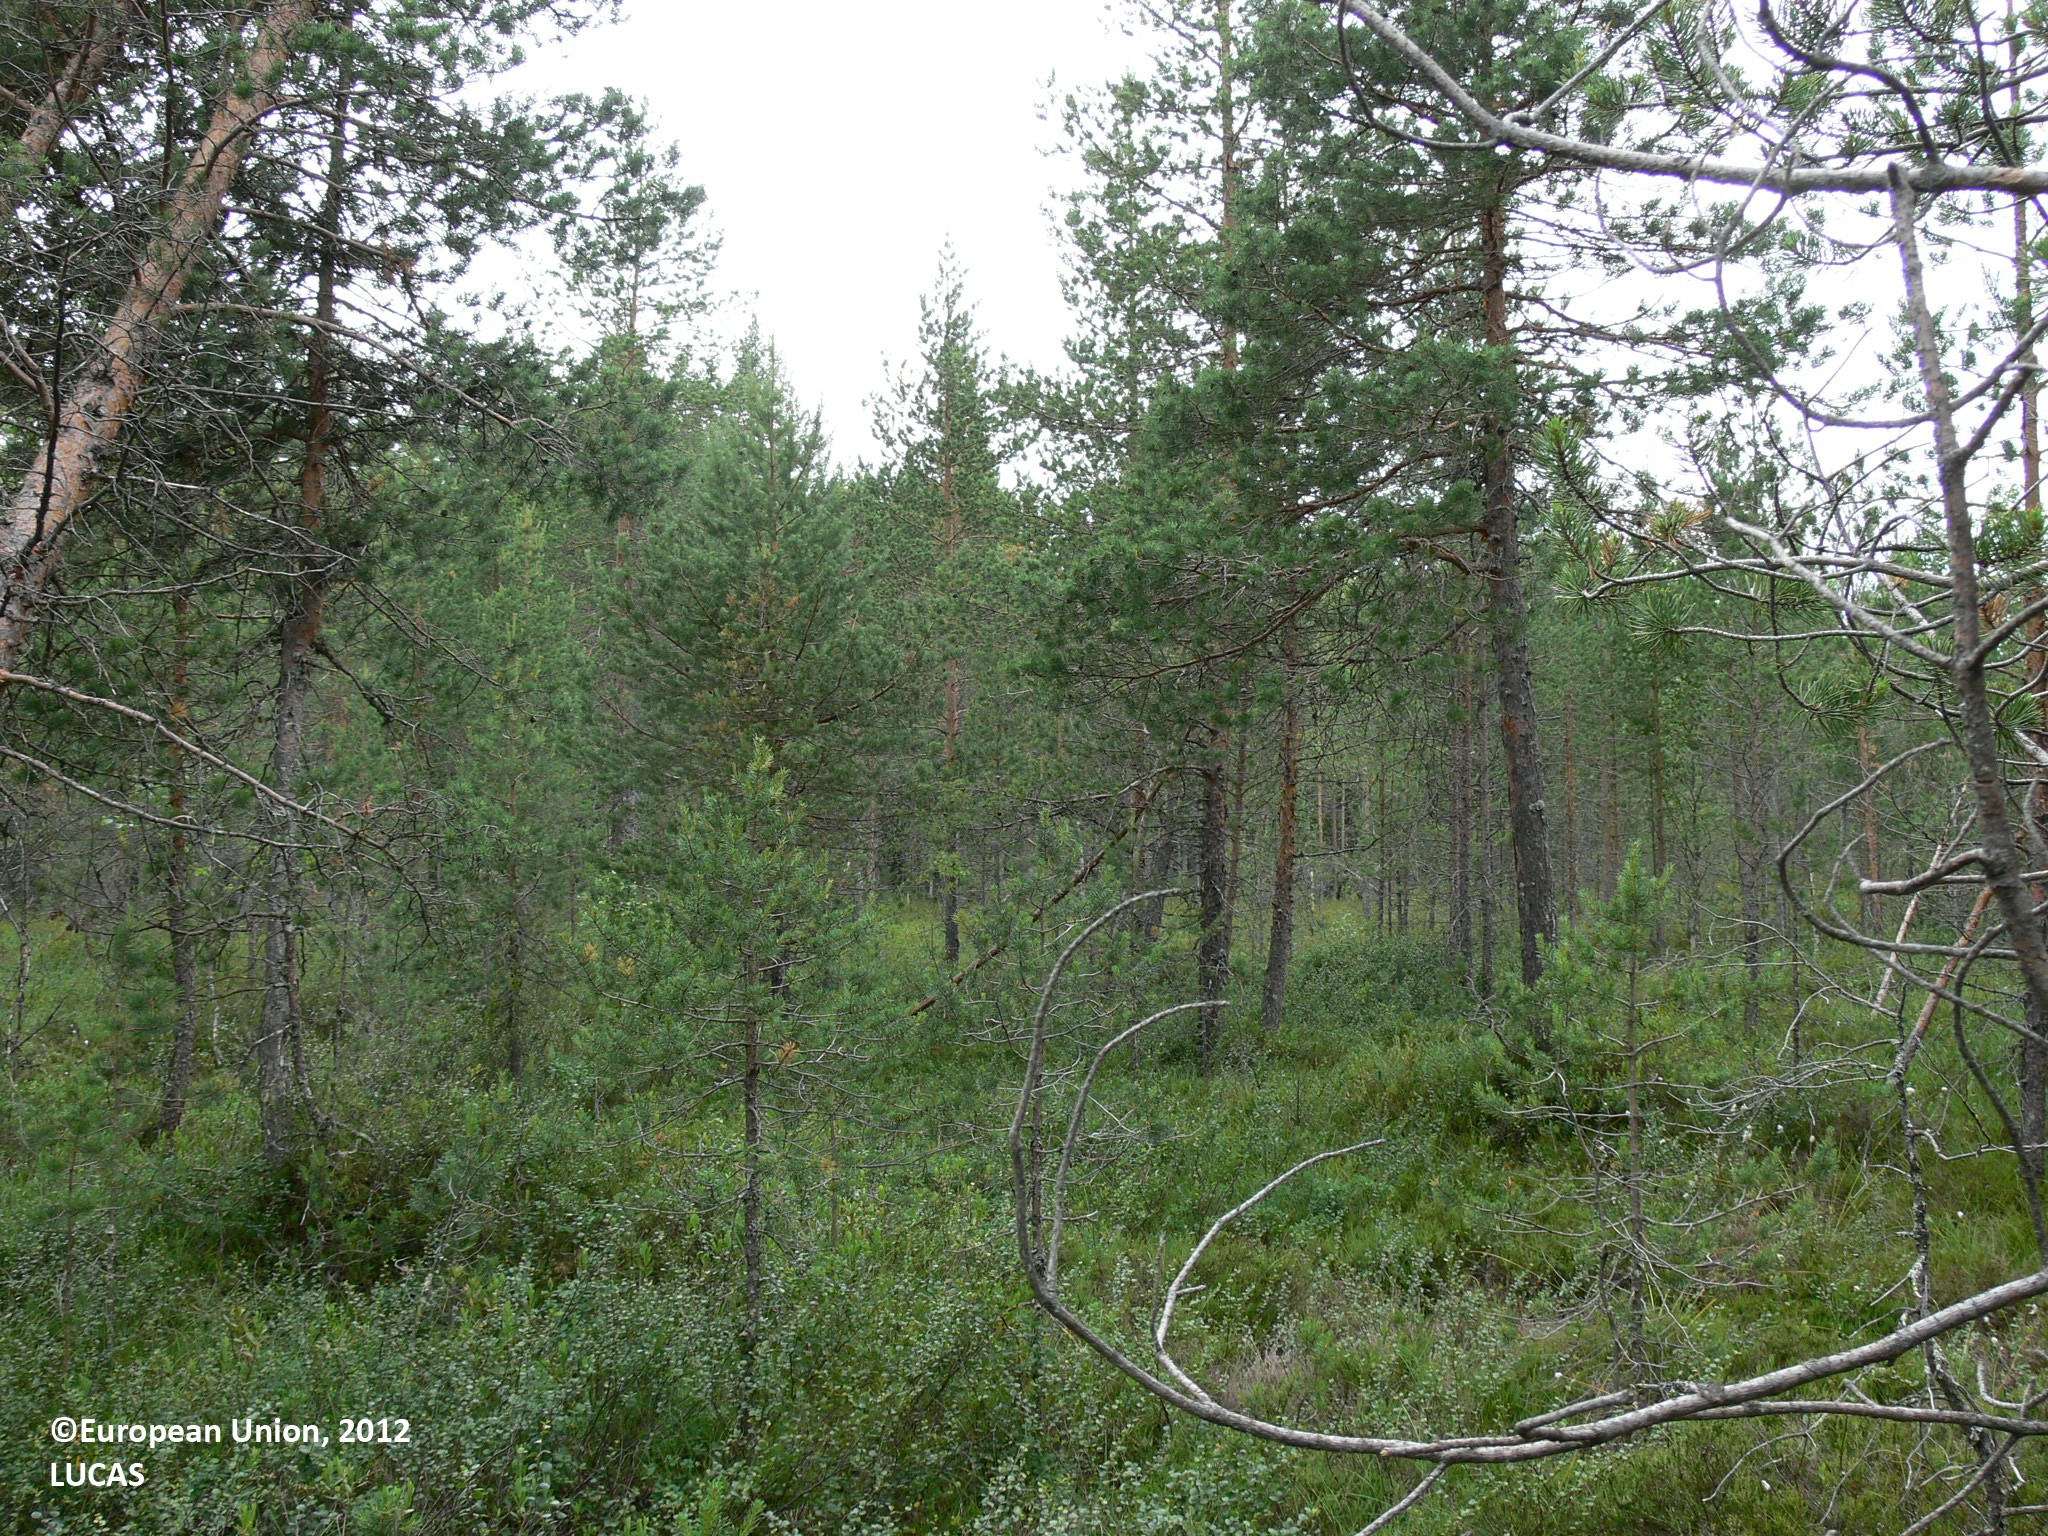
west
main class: Woodland
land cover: Pine dominated mixed woodland
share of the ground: 50 - 75 %
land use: Forestry
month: July
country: FI
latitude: 63.1723
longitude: 30.7209
